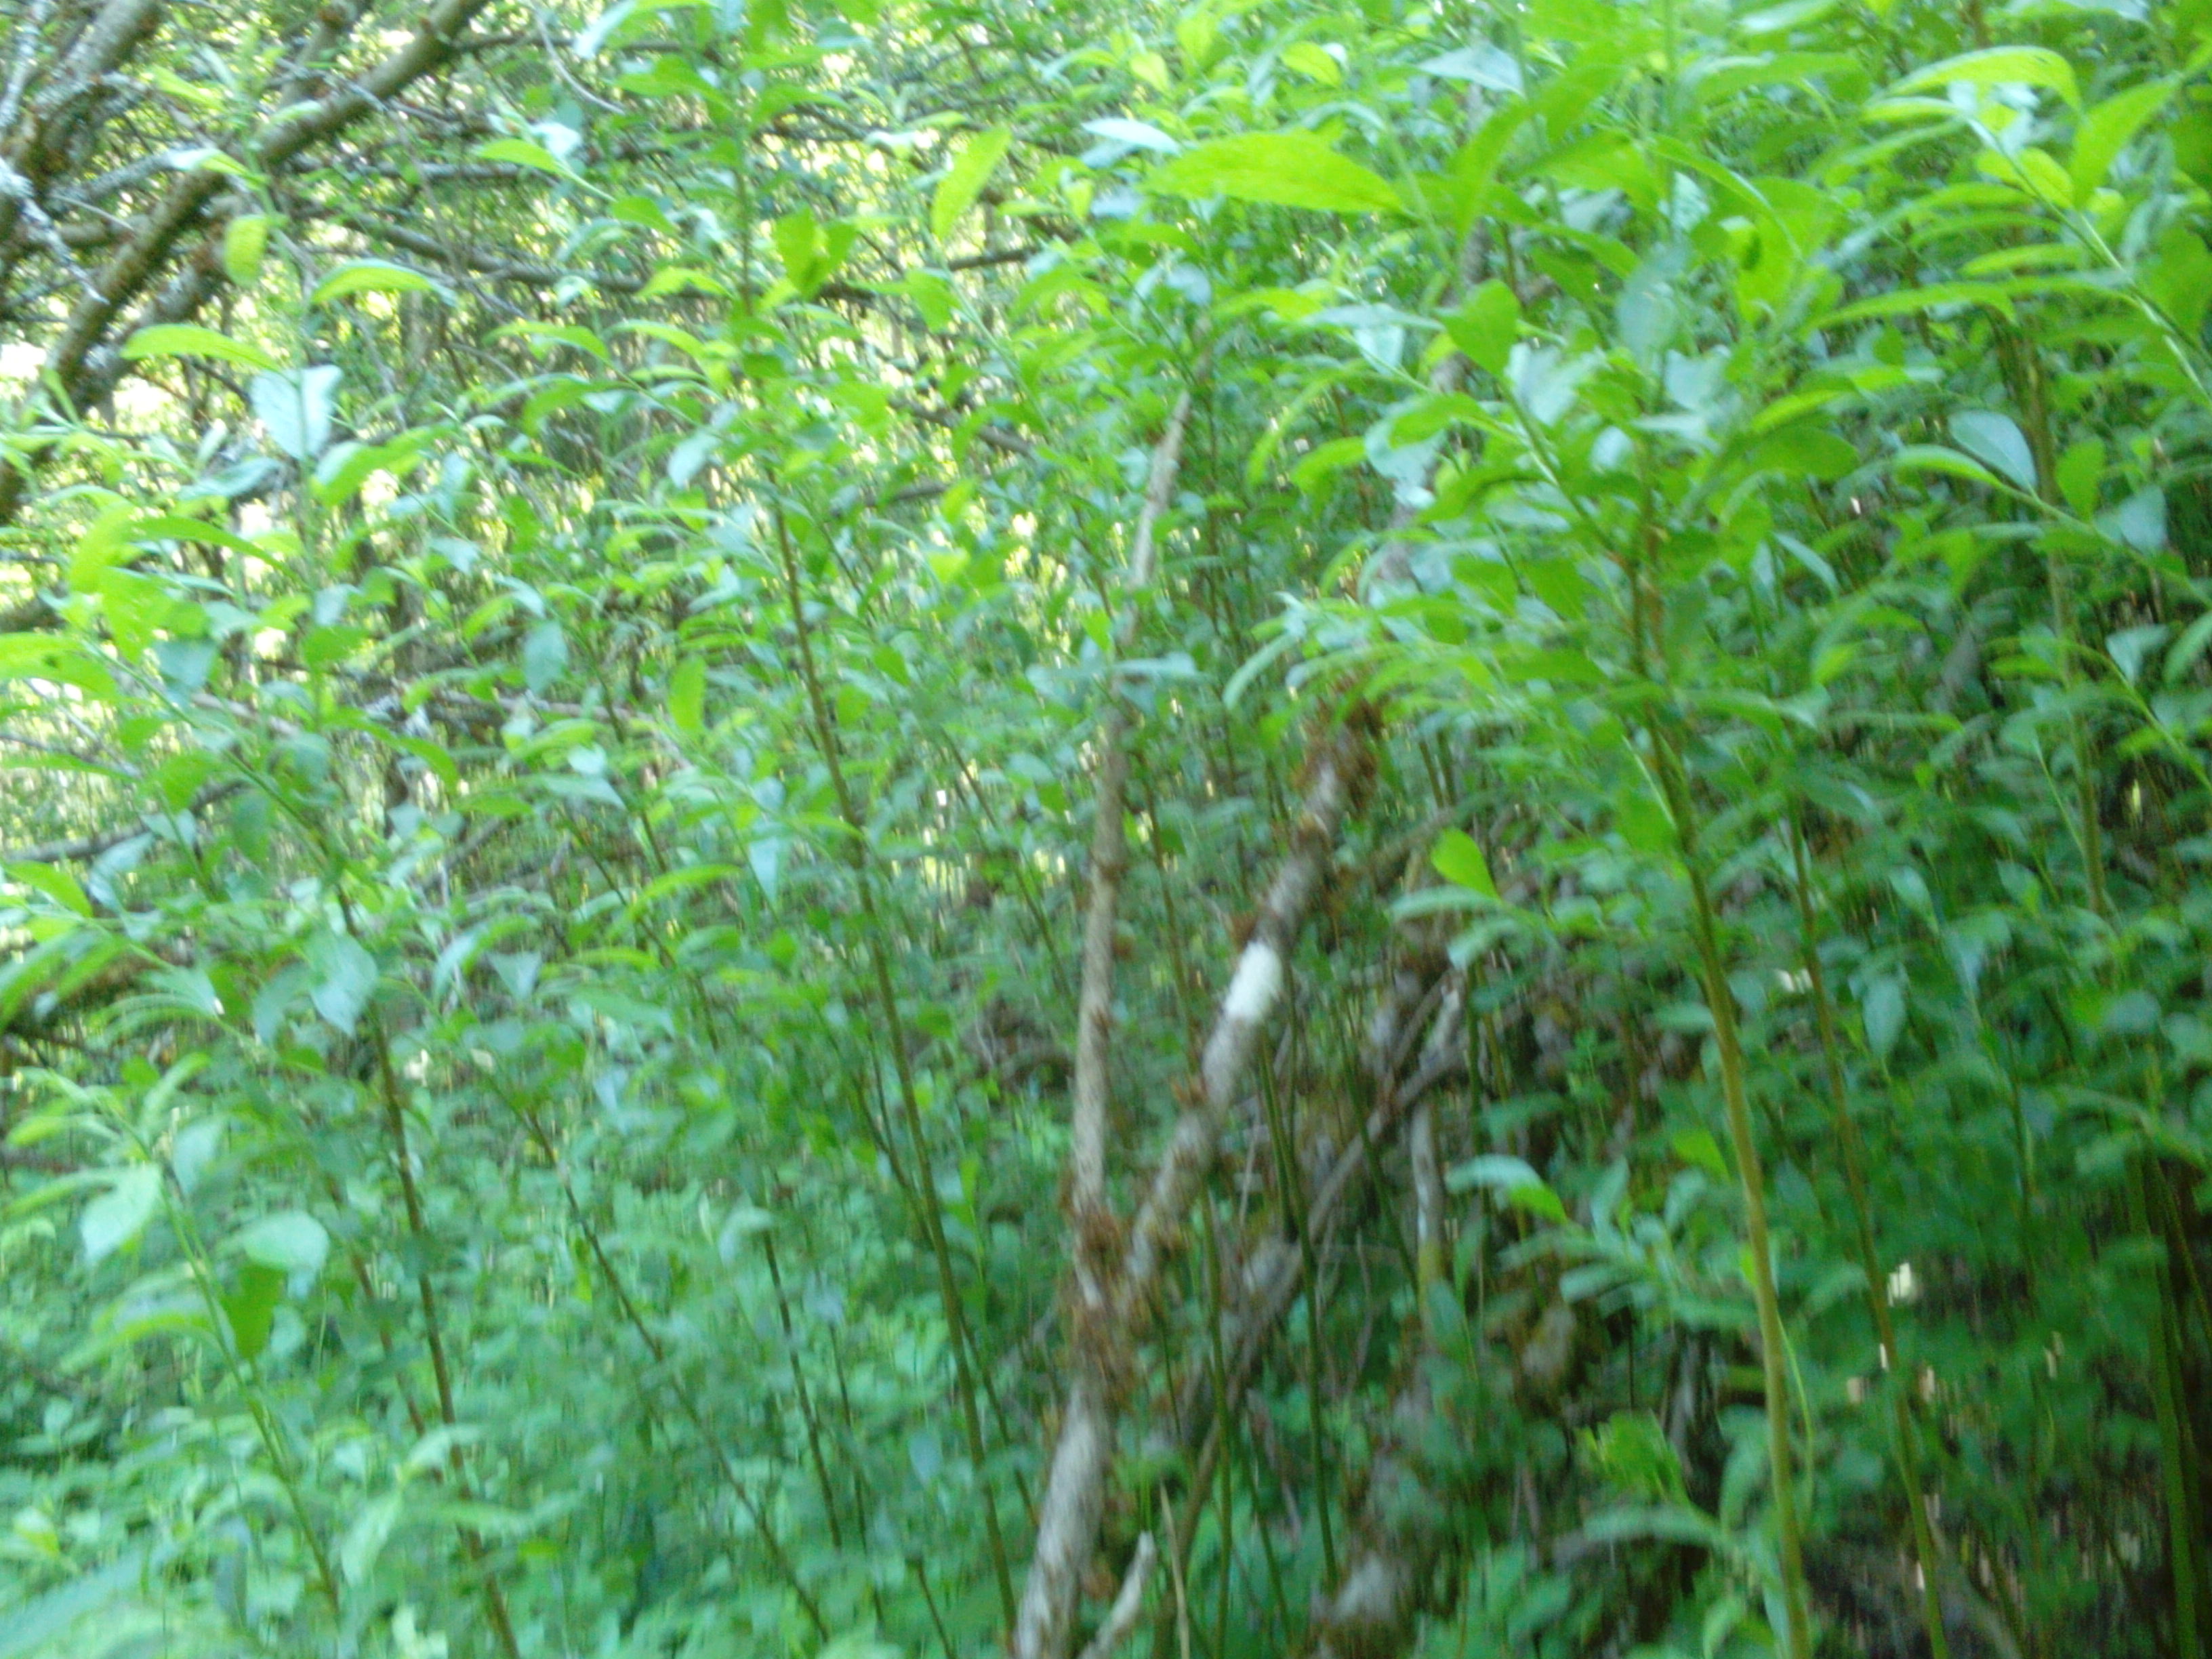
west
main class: Woodland
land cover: Spruce dominated mixed woodland
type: hemiboreal forest and nemoral coniferous forest and mixed broadleaved-coniferous forest
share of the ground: > 75 %
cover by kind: coniferous forest trees 50 %, broadleaved forest trees 50 %
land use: Forestry
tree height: > 5 m
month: June
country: LV
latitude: 56.8323
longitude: 22.2951
